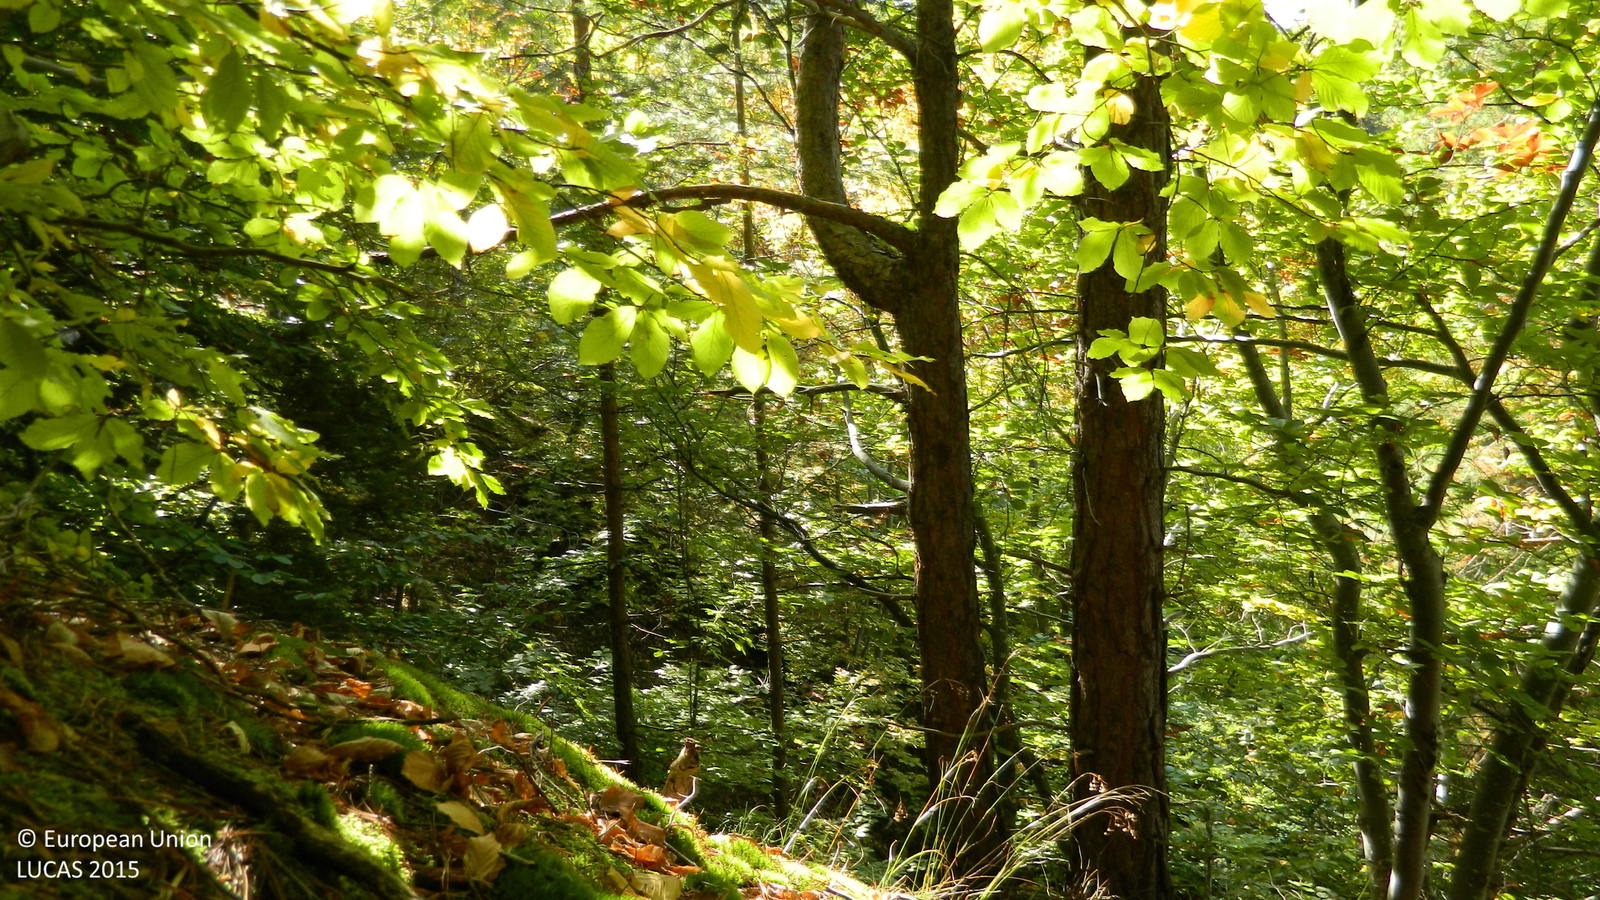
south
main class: Woodland
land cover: Pine dominated mixed woodland
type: hemiboreal forest and nemoral coniferous forest and mixed broadleaved-coniferous forest
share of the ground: > 75 %
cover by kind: coniferous forest trees 55 %, broadleaved forest trees 45 %
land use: Forestry
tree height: > 5 m
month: October
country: BG
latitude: 41.6684
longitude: 25.0525
